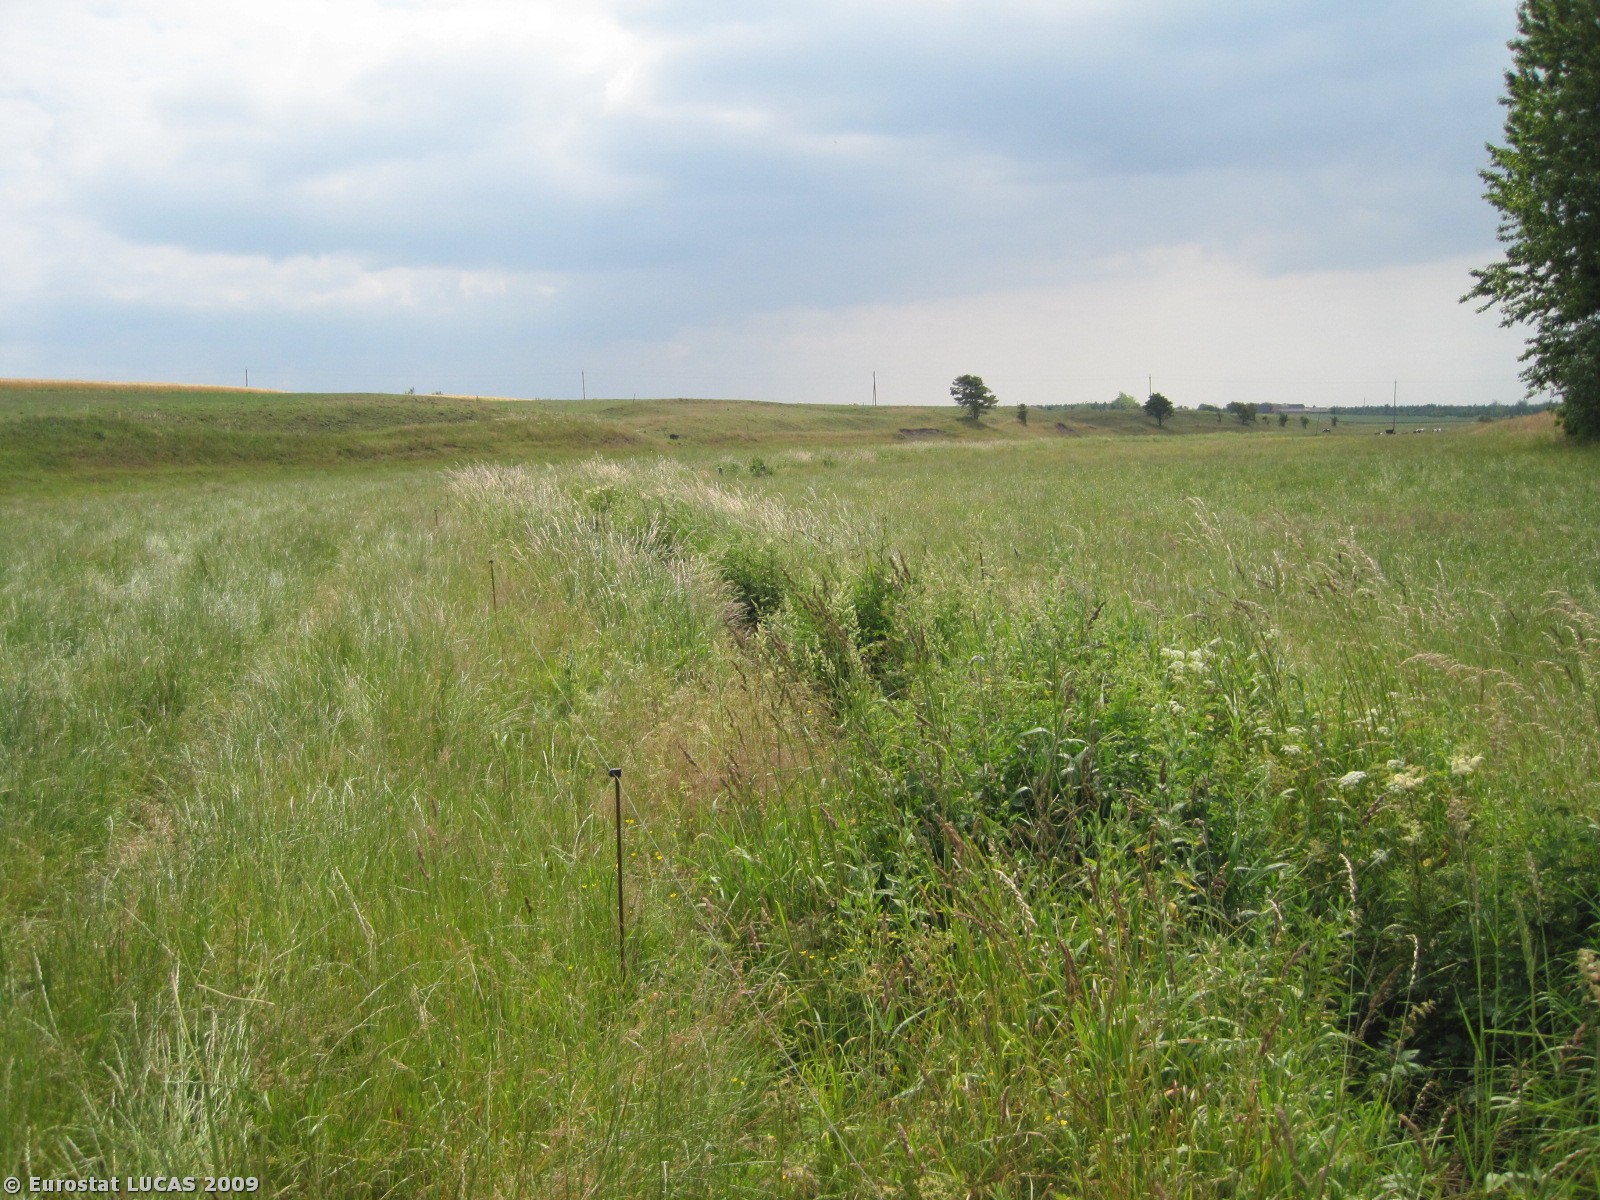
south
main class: Grassland
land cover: Grassland without tree/shrub cover
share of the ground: > 75 %
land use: Agriculture (excluding fallow land and kitchen gardens)
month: June
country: DK
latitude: 56.5017
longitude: 8.4261
